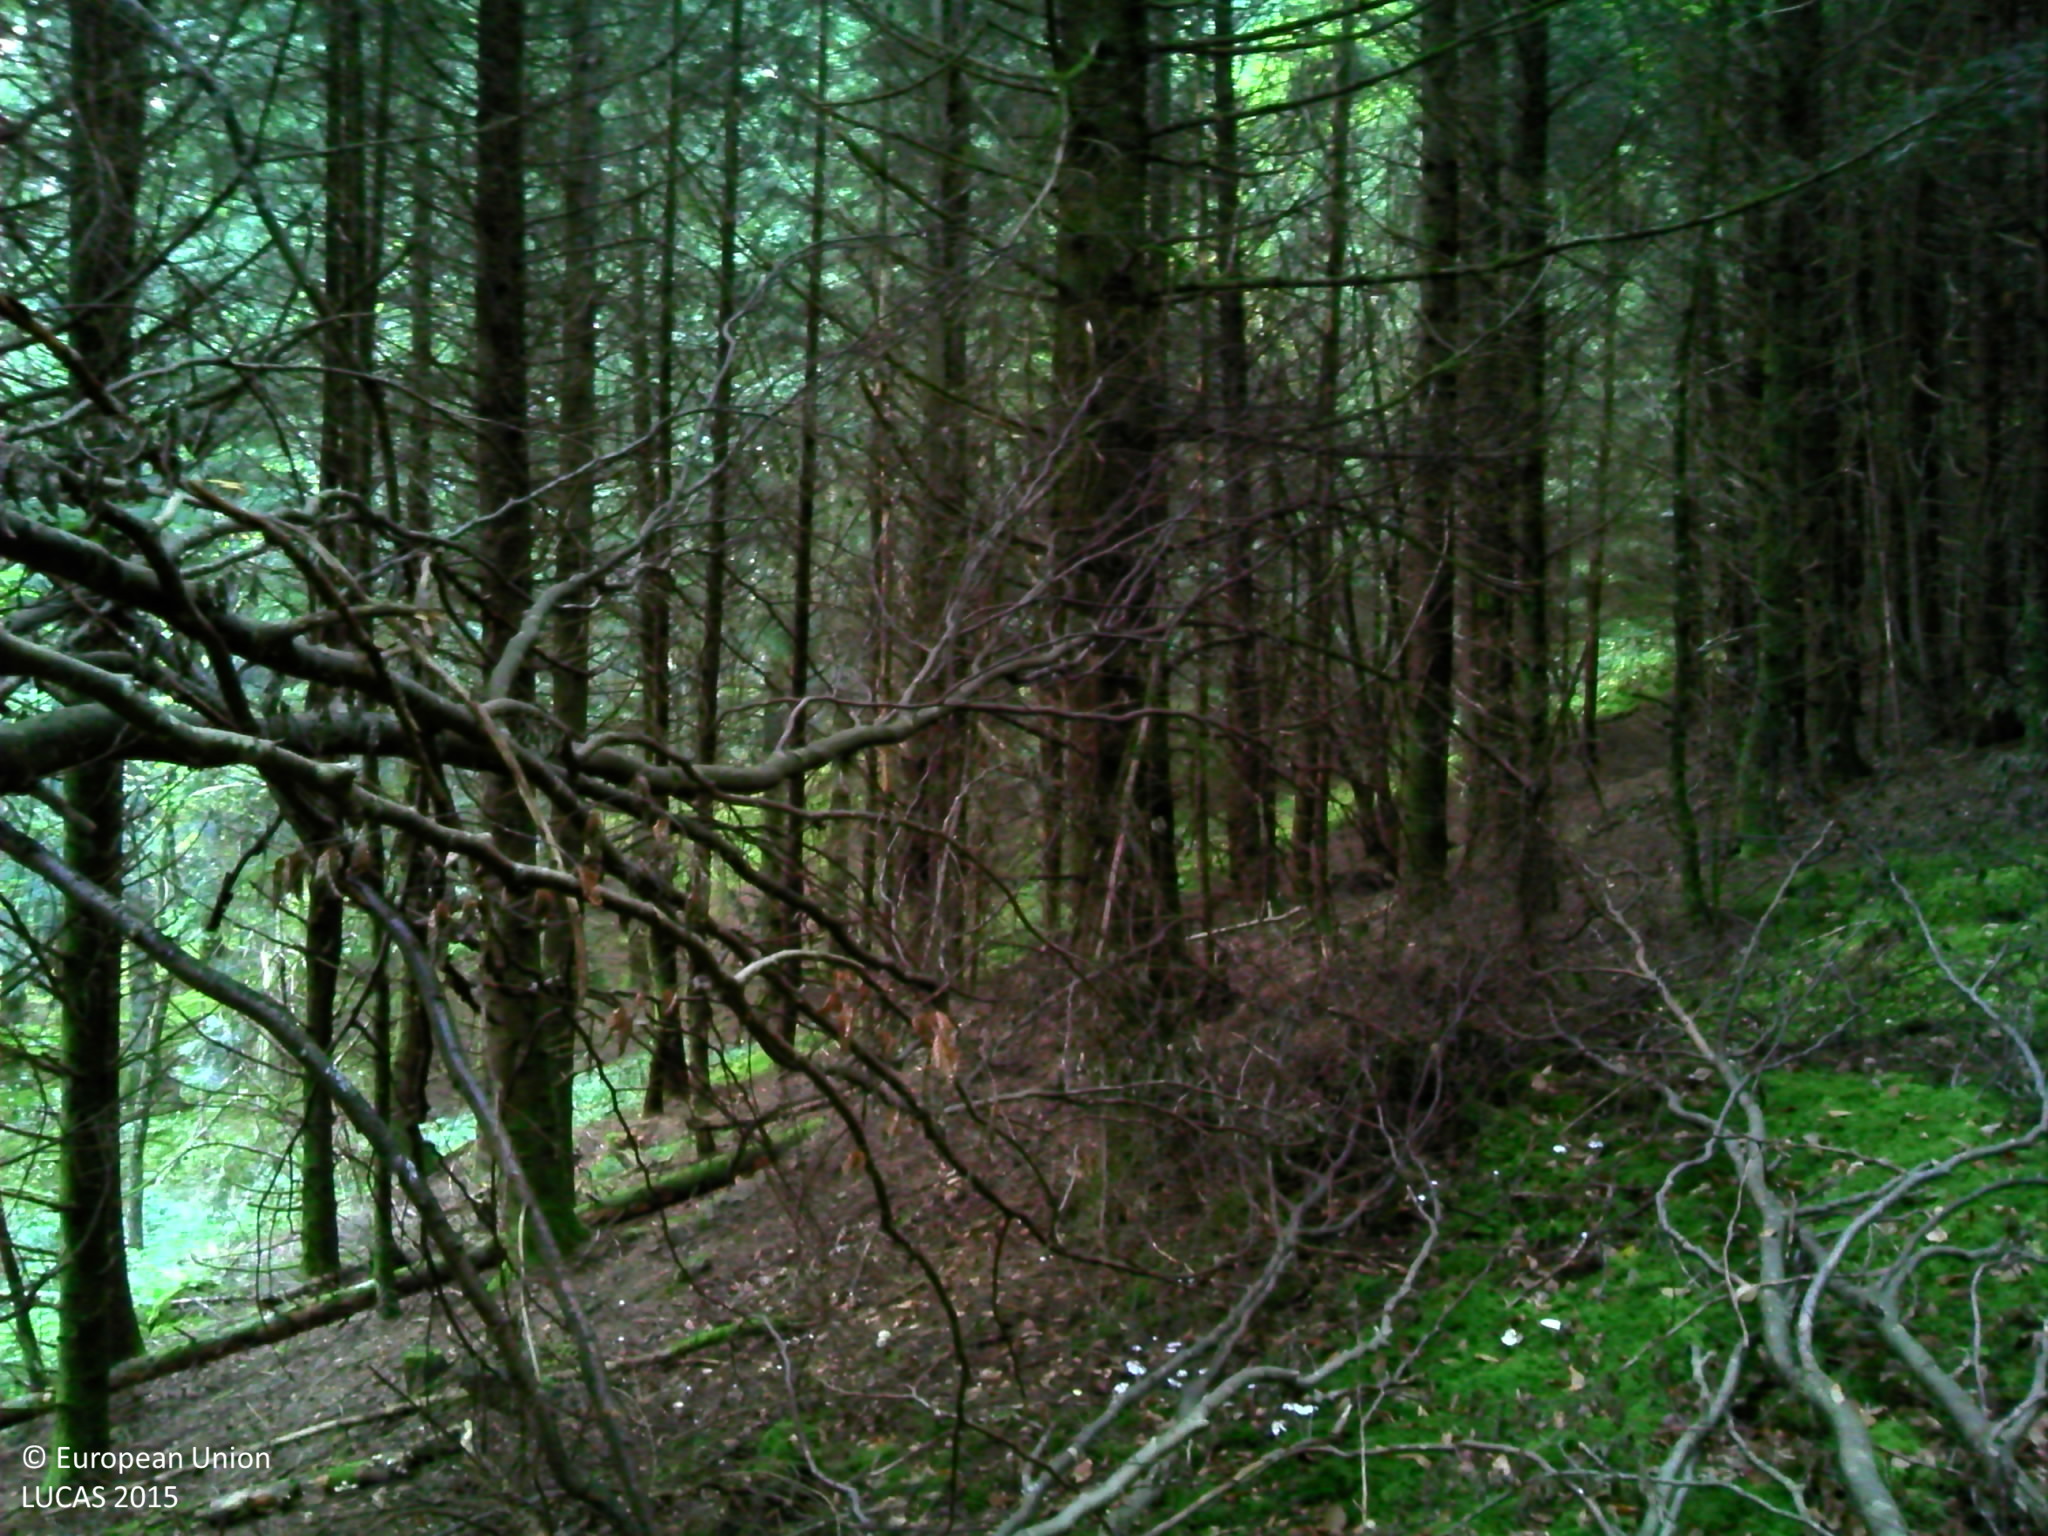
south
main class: Woodland
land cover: Other coniferous woodland
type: exotic forest
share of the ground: 50 - 75 %
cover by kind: coniferous forest trees 60 %, lichens and mosses 30 %, broadleaved forest trees 5 %, herbaceous plants 5 %
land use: Forestry
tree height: > 5 m
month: October
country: FR
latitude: 45.9090
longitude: 2.7920
